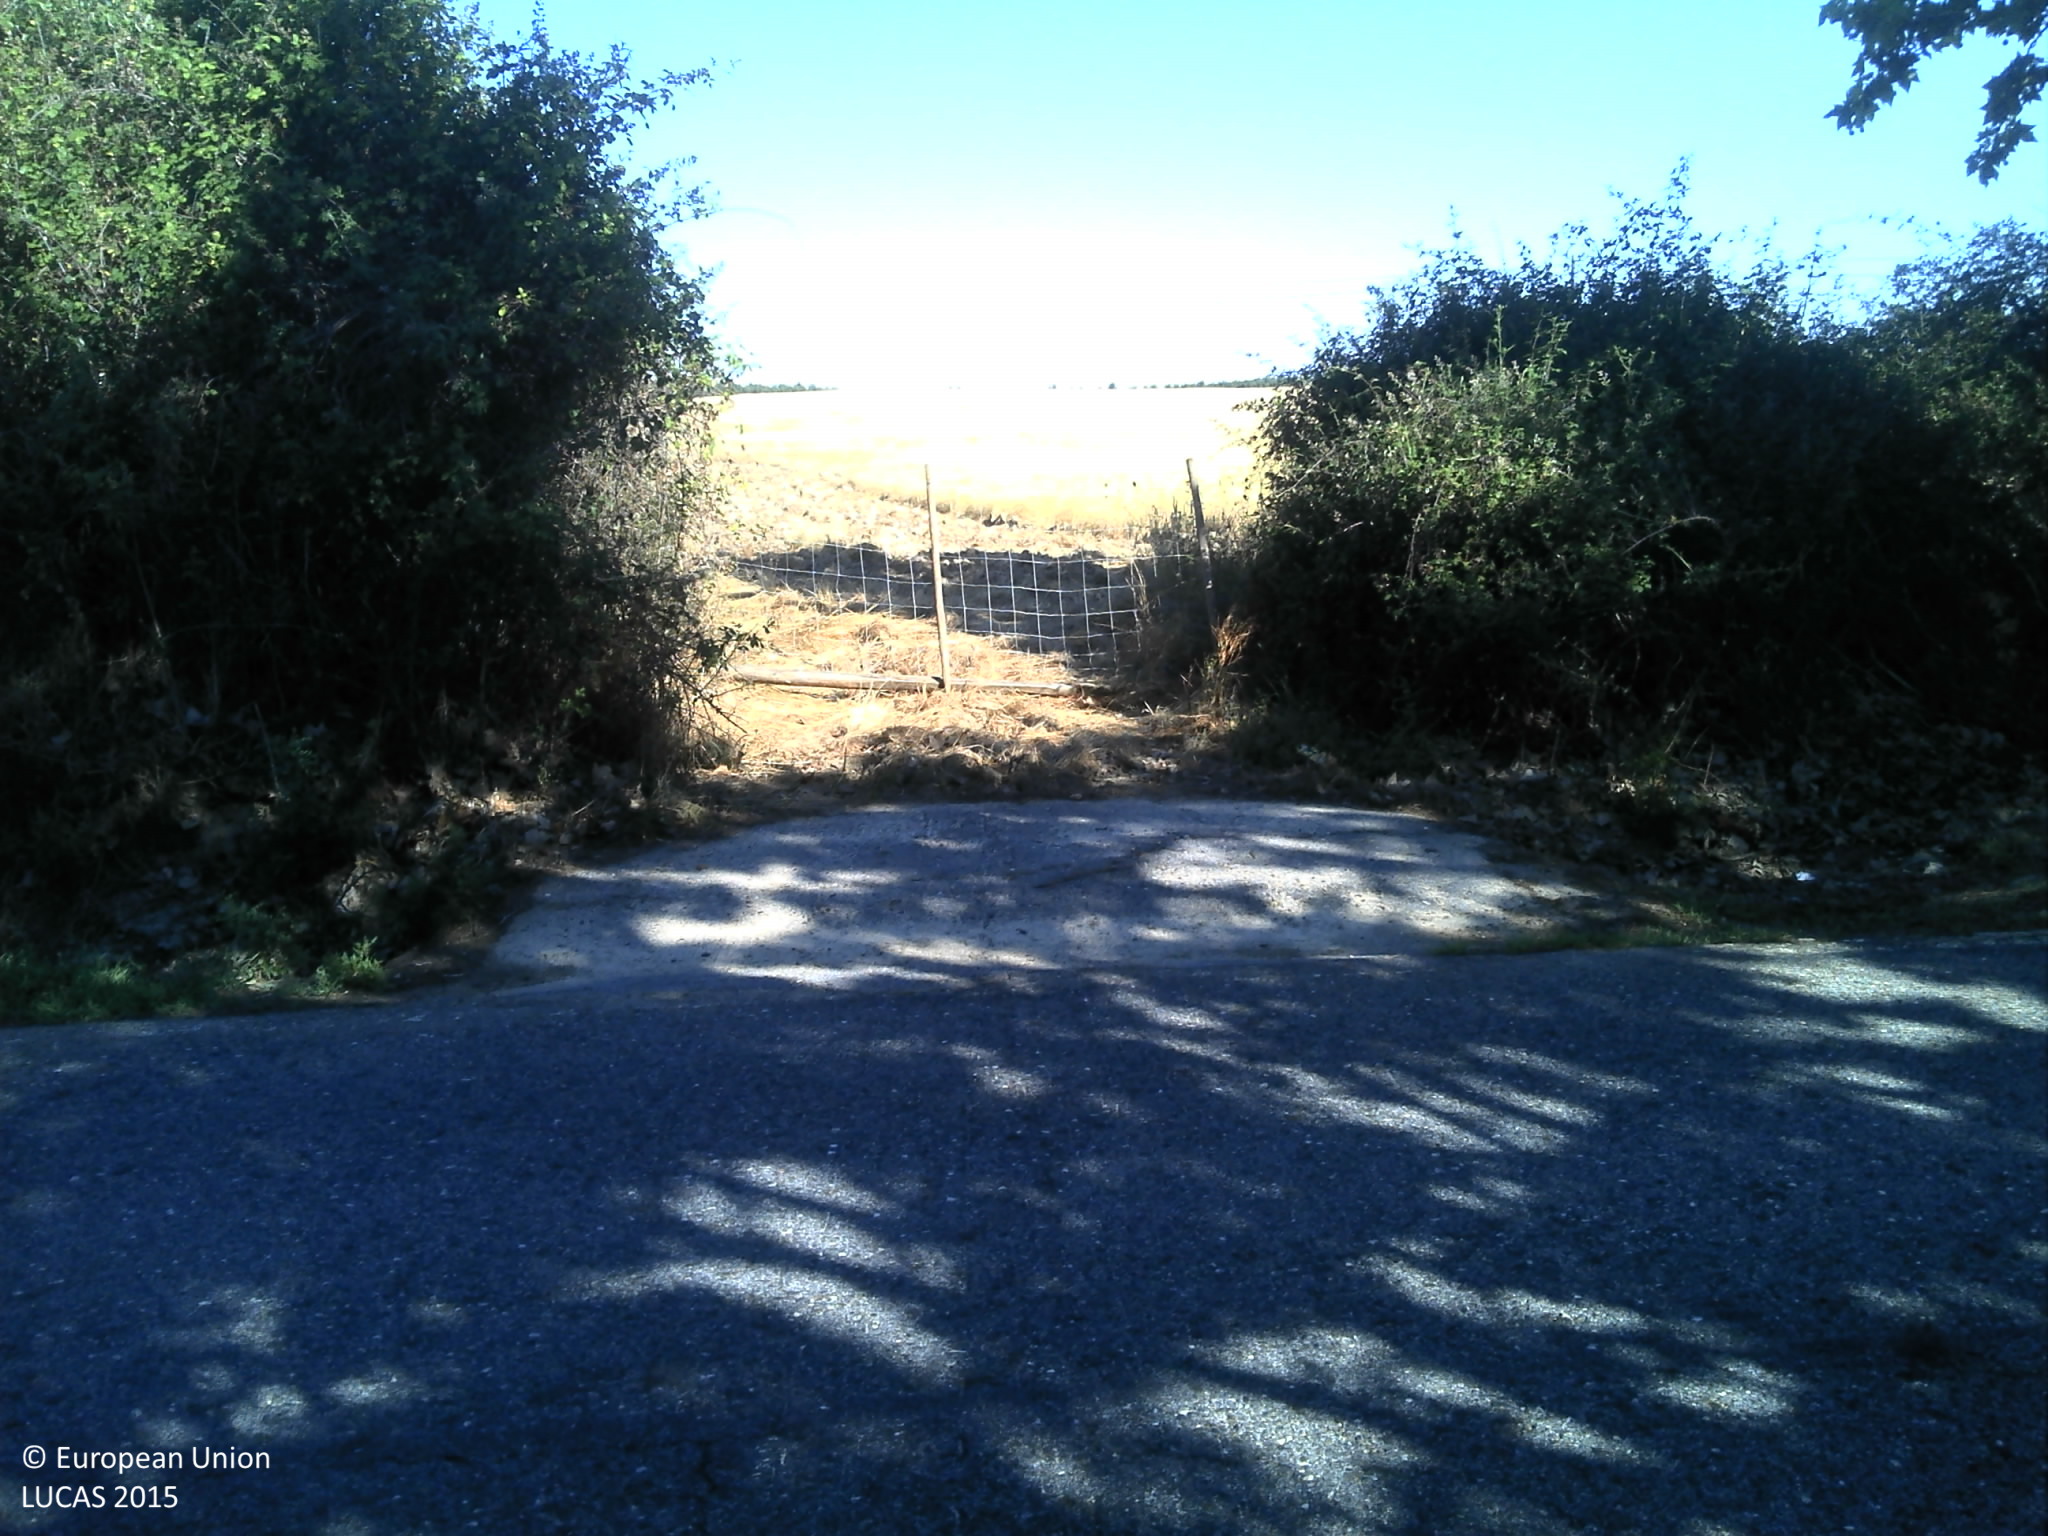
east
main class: Grassland
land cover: Grassland without tree/shrub cover
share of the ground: 50 - 75 %
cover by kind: herbaceous plants 70 %, unconsolidated bare surface 20 %
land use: Agriculture (excluding fallow land and kitchen gardens)
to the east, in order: Grassland without tree/shrub cover; Grass margins; Rivers and streams; Grass margins; Grassland without tree/shrub cover; Single bushes/trees; Grassland without tree/shrub cover; Tracks
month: June
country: PT
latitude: 39.9442
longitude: -7.1452
